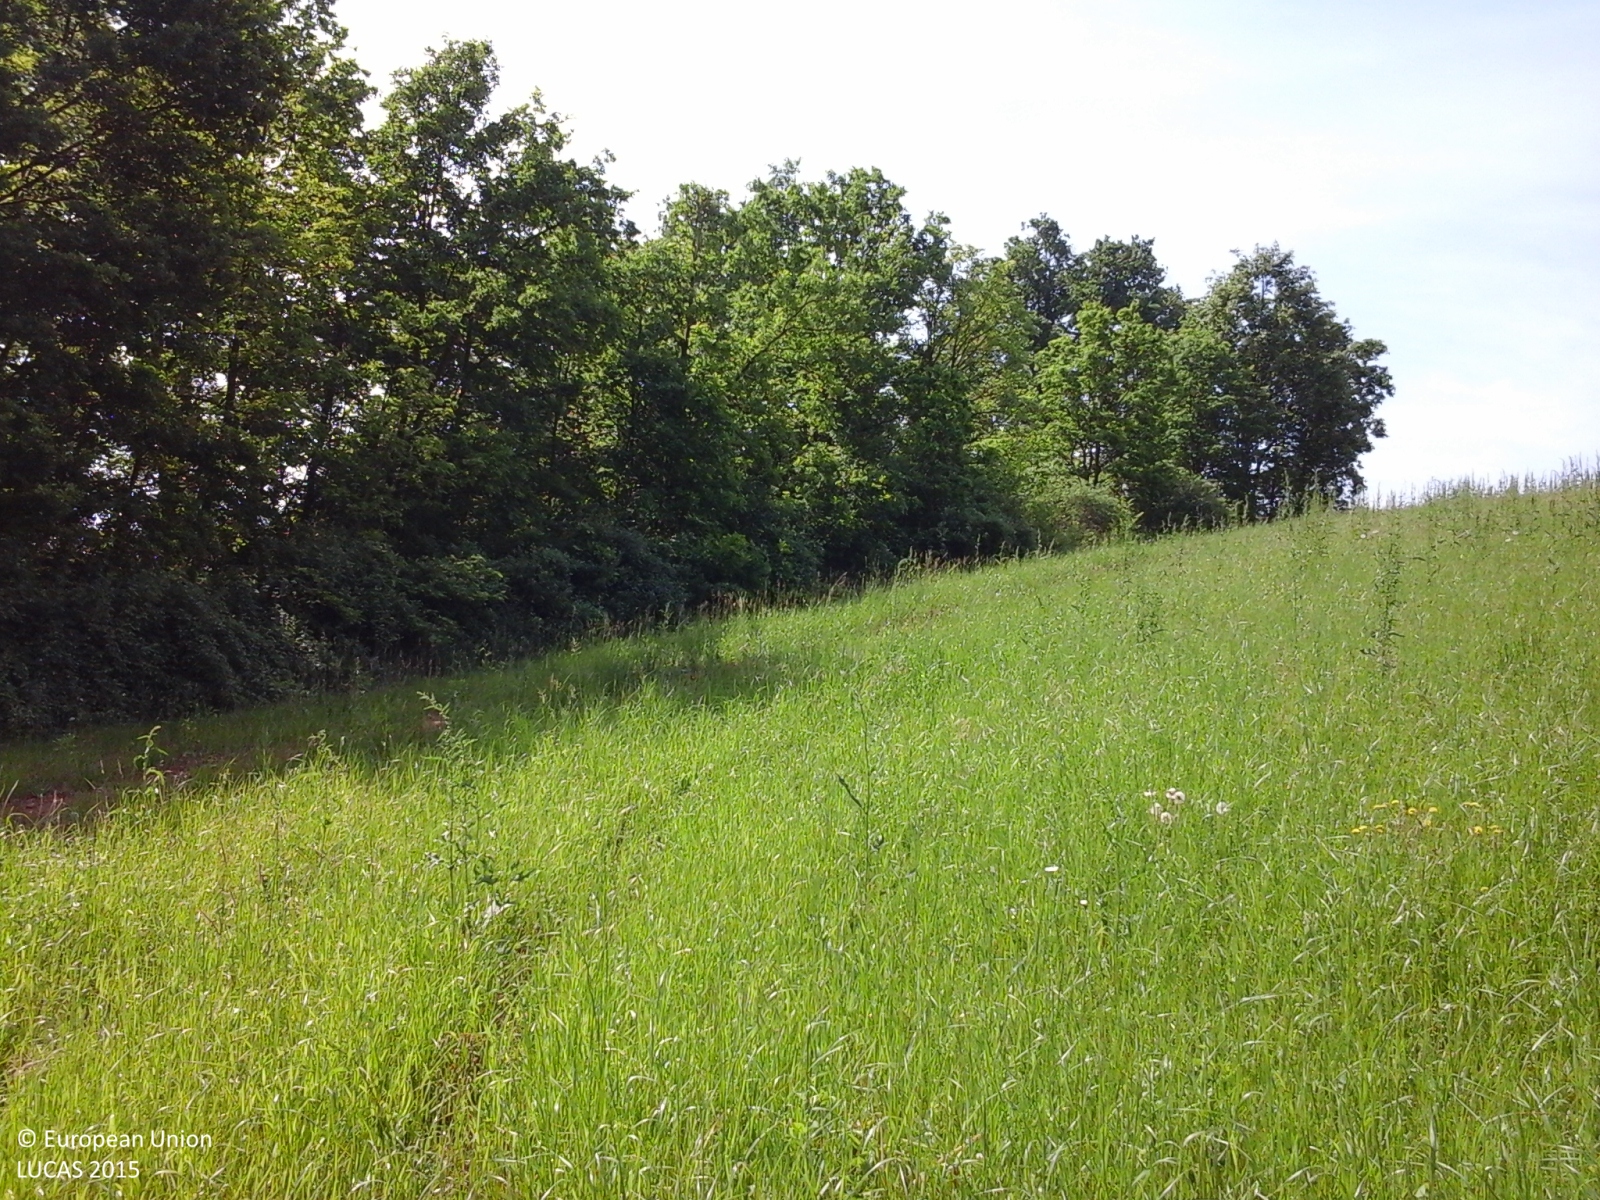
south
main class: Cropland
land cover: Temporary grasslands
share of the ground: > 75 %
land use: Agriculture (excluding fallow land and kitchen gardens)
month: May
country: IT
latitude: 44.9333
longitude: 8.3938
